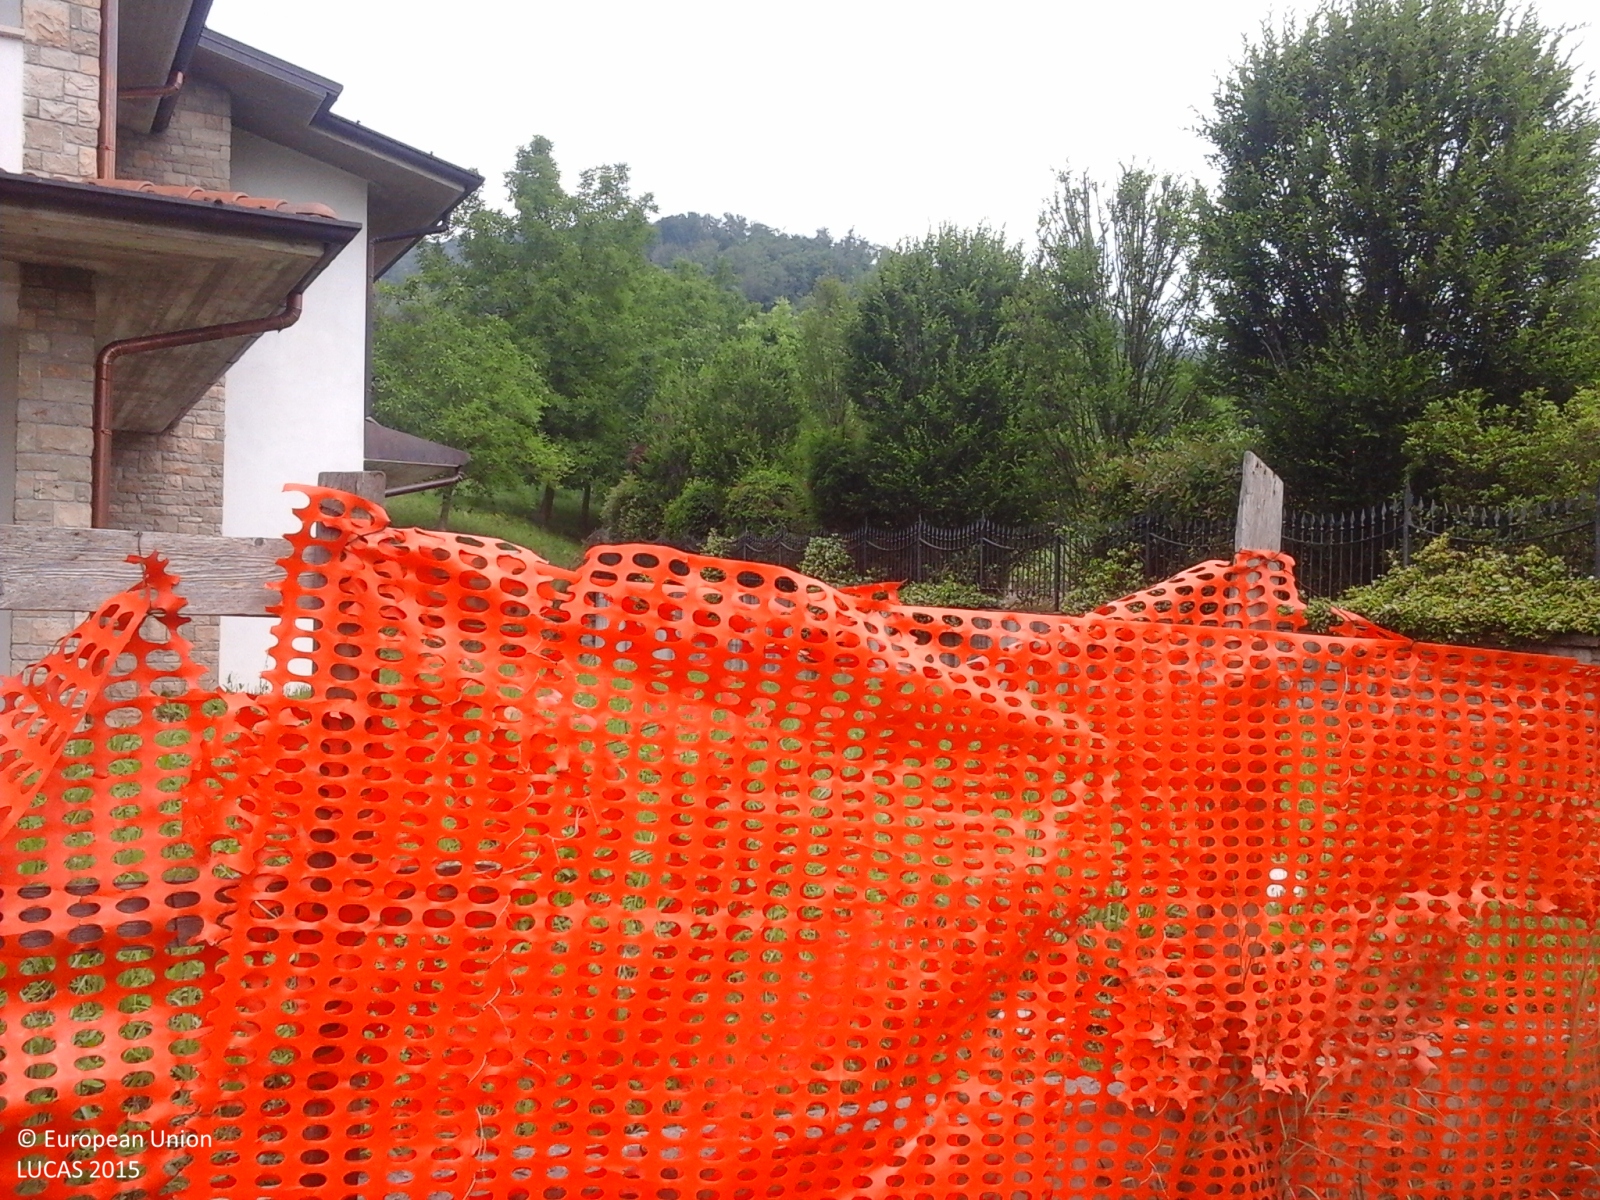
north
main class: Grassland
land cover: Grassland without tree/shrub cover
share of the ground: > 75 %
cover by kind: herbaceous plants 100 %
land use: Construction
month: June
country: IT
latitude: 45.6666
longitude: 9.9103
